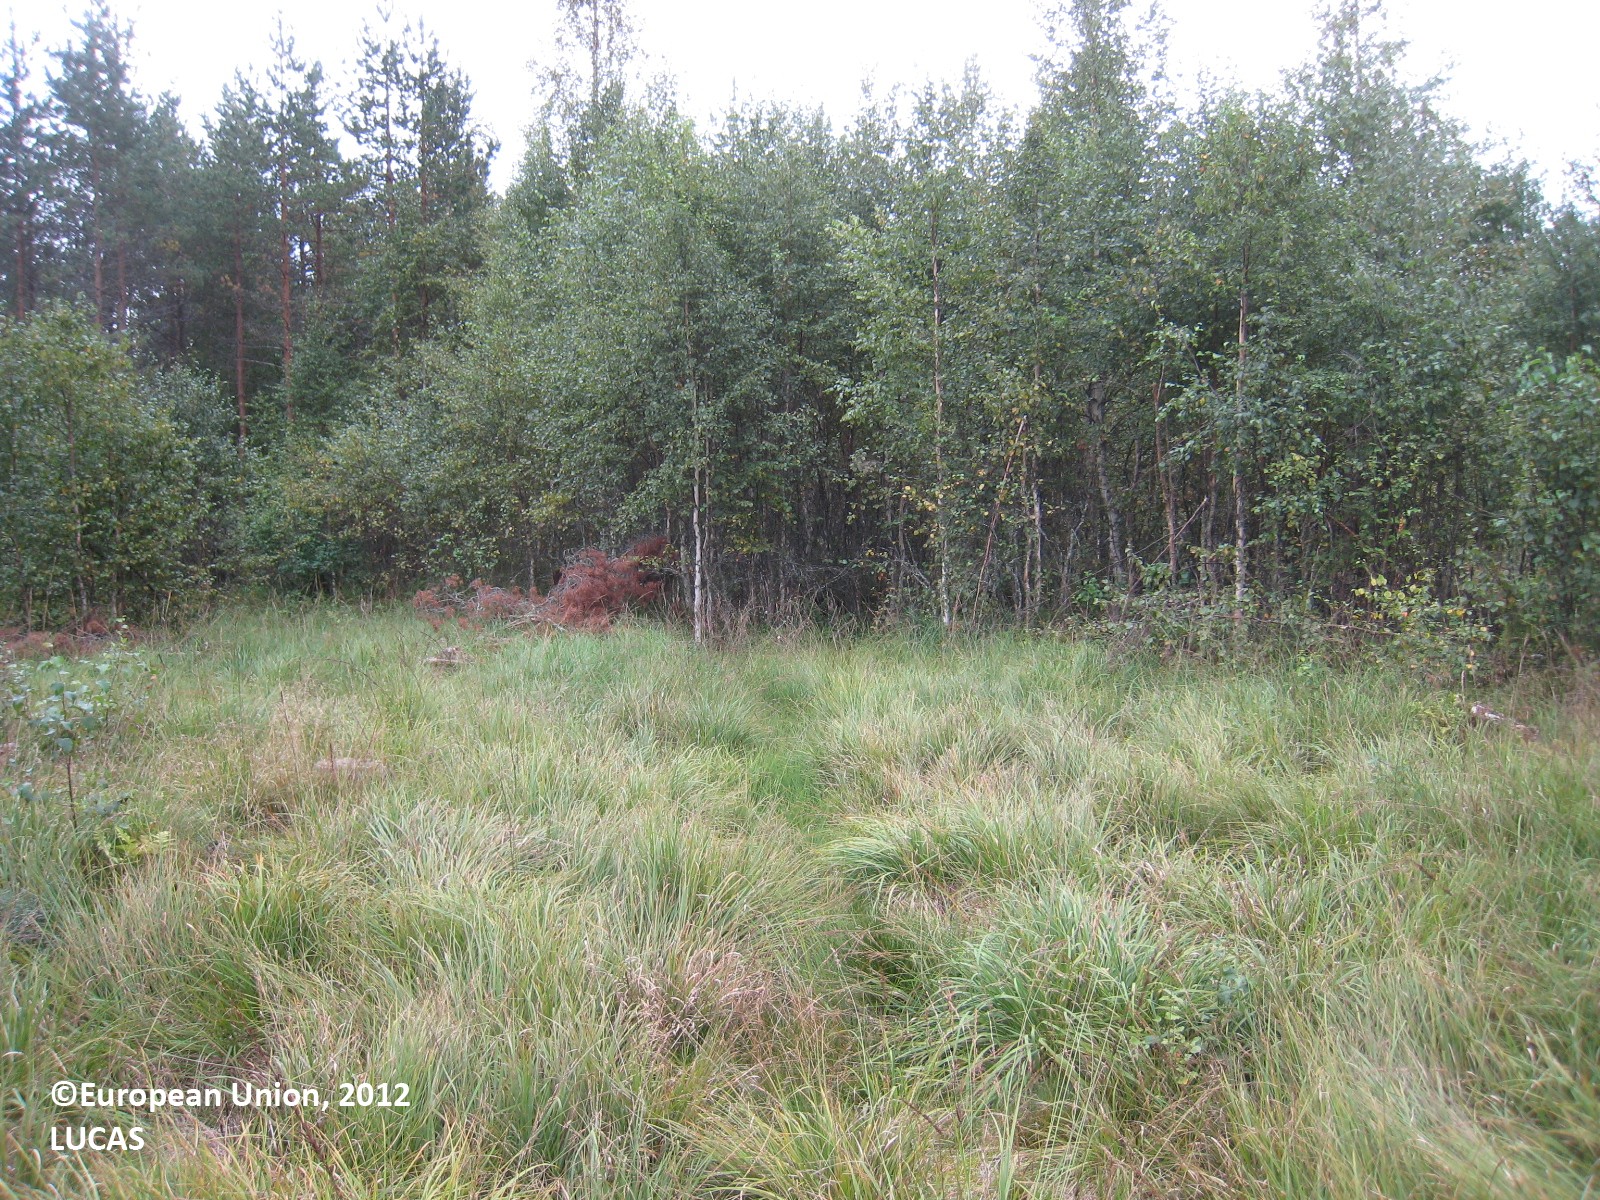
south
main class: Grassland
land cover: Grassland with sparse tree/shrub cover
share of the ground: > 75 %
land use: Forestry
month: August
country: FI
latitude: 61.8548
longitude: 26.0373
